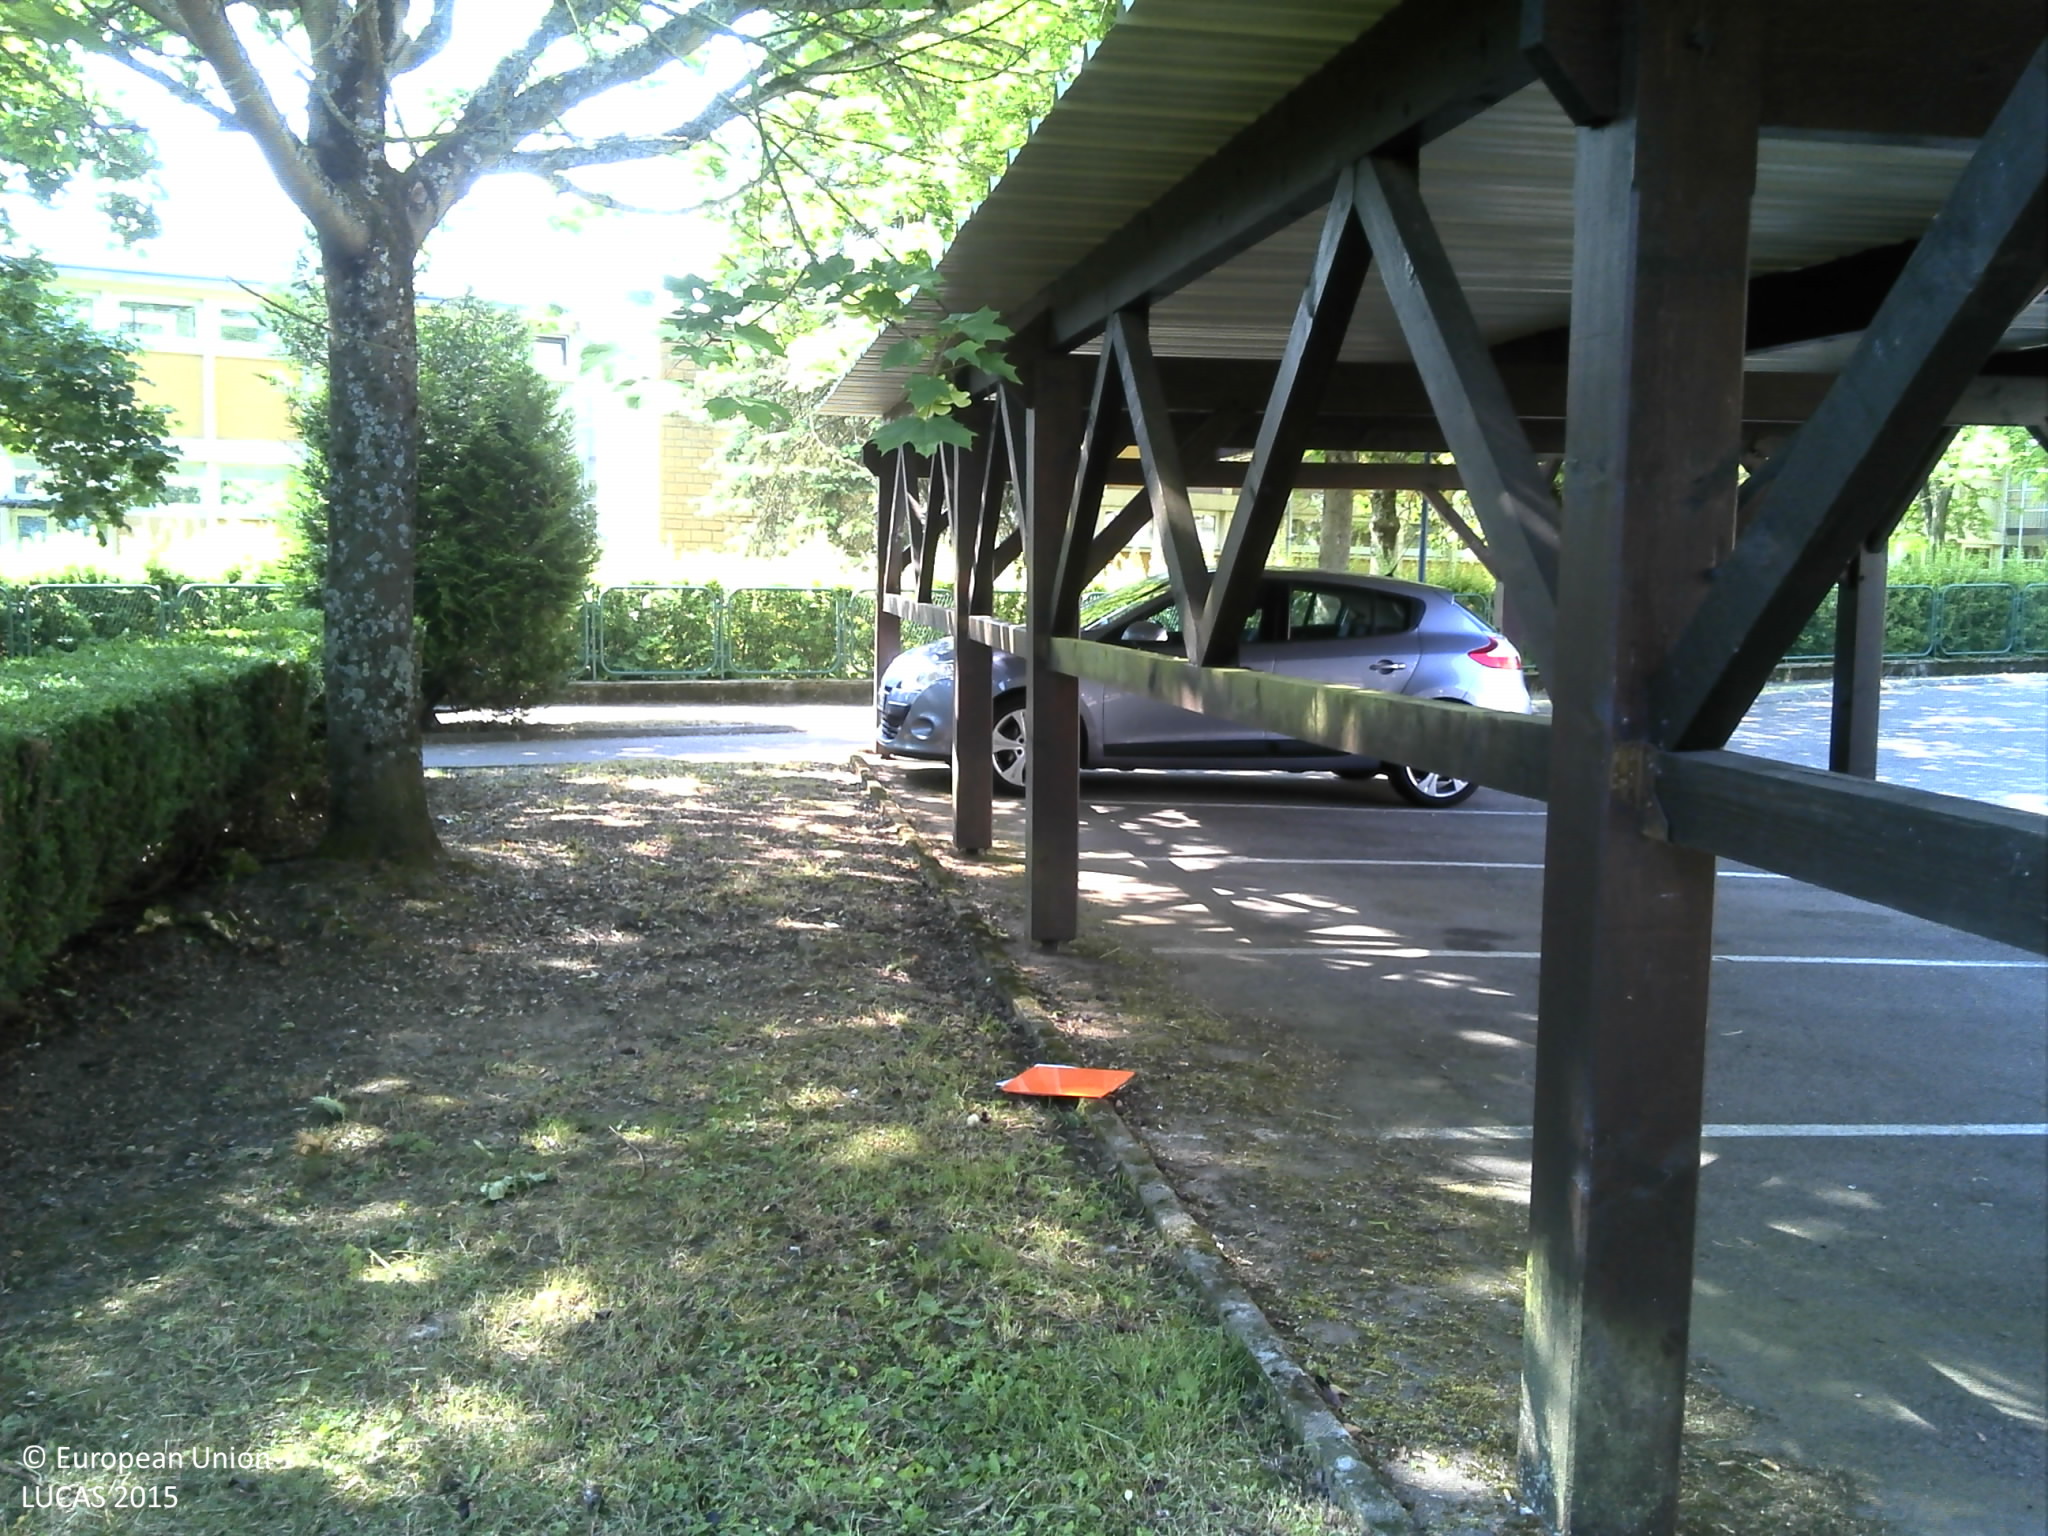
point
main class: Woodland
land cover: Broadleaved woodland
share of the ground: 25 - 50 %
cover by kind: herbaceous plants 60 %, broadleaved forest trees 40 %
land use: Residential
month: June
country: FR
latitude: 49.0939
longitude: 6.1789
